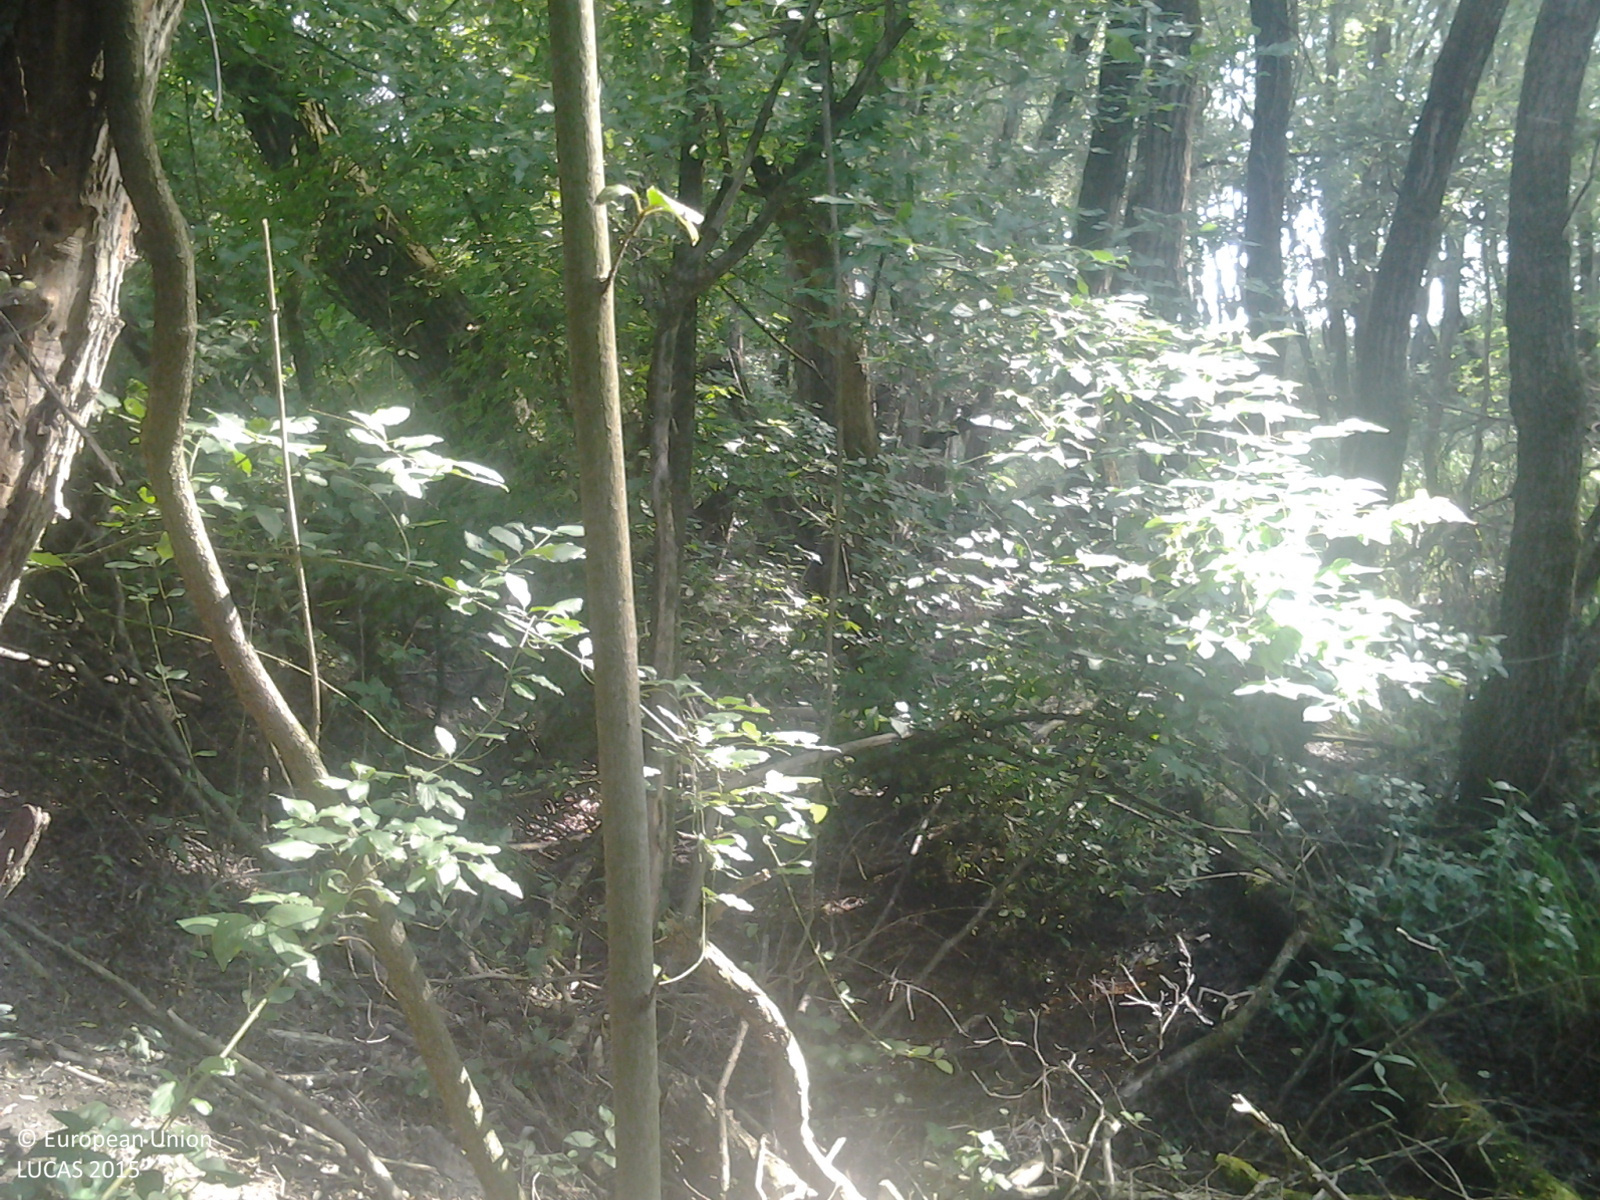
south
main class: Woodland
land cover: Broadleaved woodland
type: mesophytic deciduous forest
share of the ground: > 75 %
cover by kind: broadleaved forest trees 95 %, shrubs 5 %
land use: Forestry
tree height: > 5 m
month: June
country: HU
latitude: 46.6069
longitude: 19.1937
